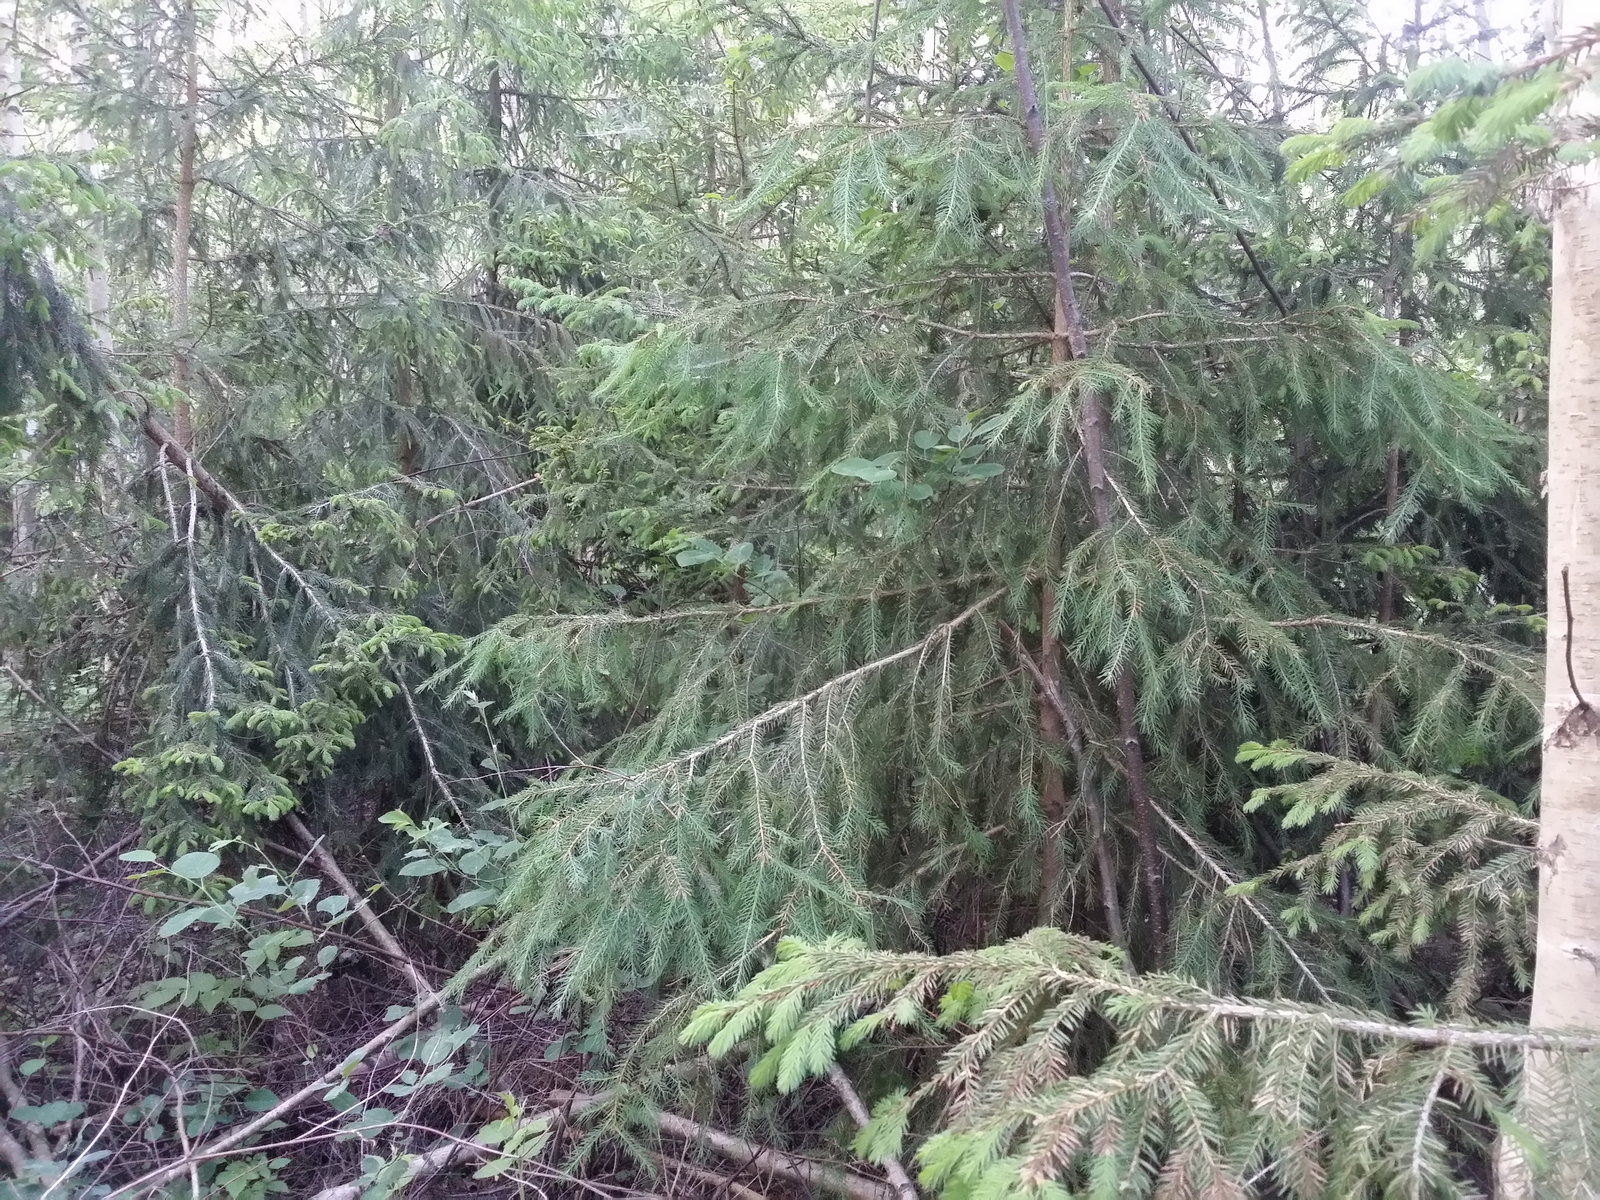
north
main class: Woodland
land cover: Spruce dominated mixed woodland
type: hemiboreal forest and nemoral coniferous forest and mixed broadleaved-coniferous forest
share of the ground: > 75 %
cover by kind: broadleaved forest trees 60 %, coniferous forest trees 20 %, shrubs 10 %, herbaceous plants 10 %
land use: Forestry
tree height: > 5 m
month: June
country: LV
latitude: 57.3052
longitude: 26.5960
